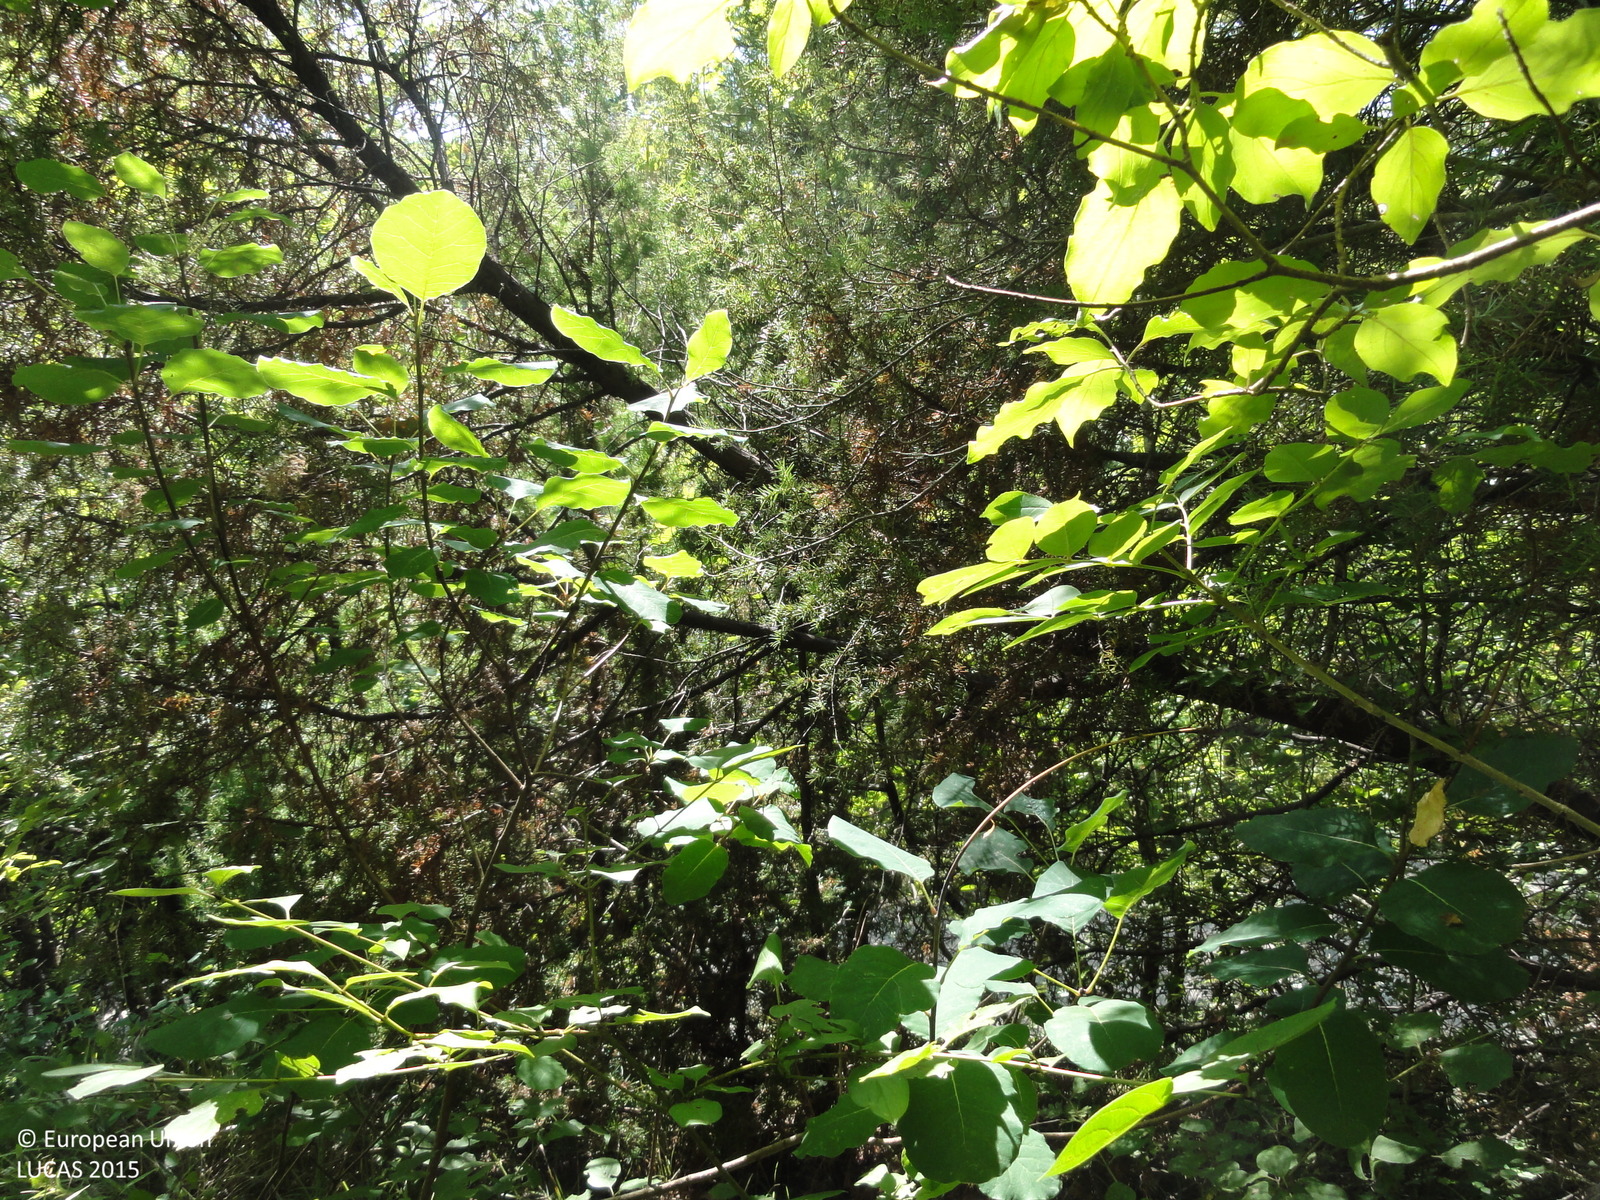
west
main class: Woodland
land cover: Broadleaved woodland
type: thermophilous deciduous forest
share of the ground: > 75 %
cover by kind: broadleaved forest trees 80 %, shrubs 20 %
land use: Semi-natural and natural areas not in use
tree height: > 5 m
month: July
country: SI
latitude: 45.4948
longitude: 13.6679
